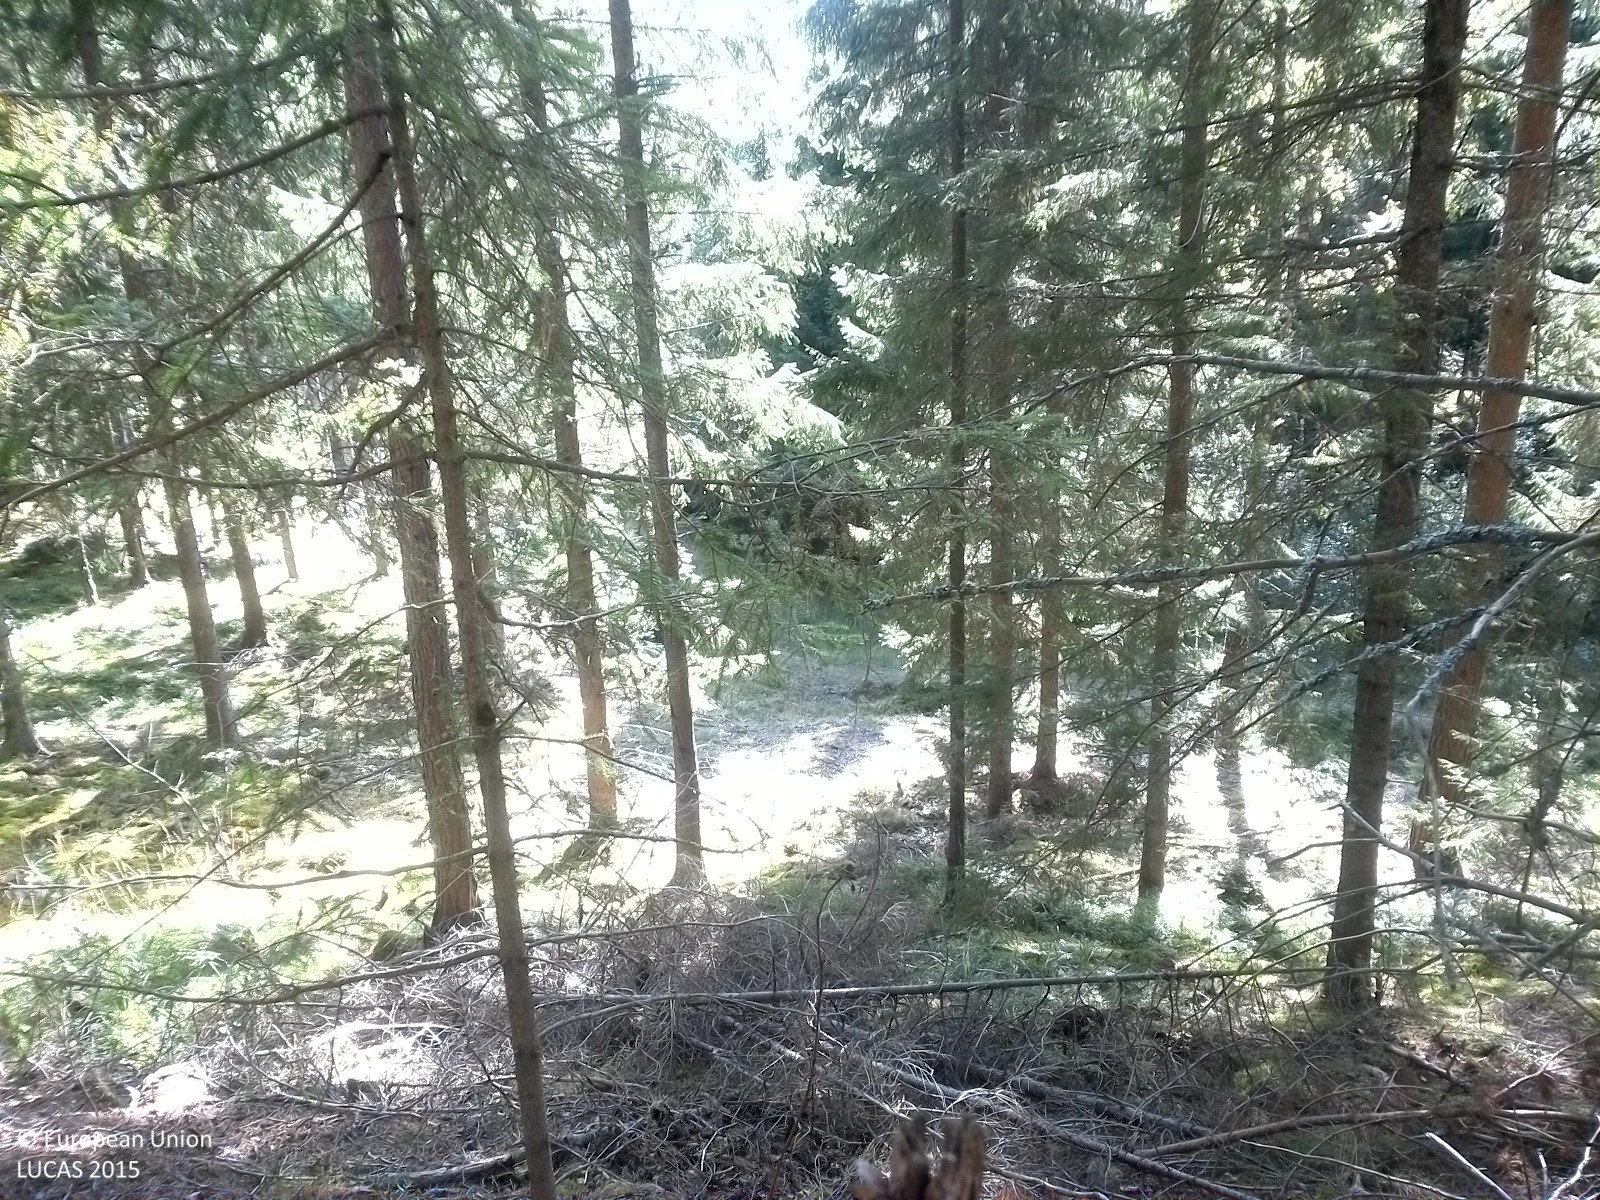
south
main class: Woodland
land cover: Other coniferous woodland
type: boreal forest
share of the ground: 25 - 50 %
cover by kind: coniferous forest trees 40 %, lichens and mosses 30 %, unconsolidated bare surface 20 %, broadleaved forest trees 5 %, herbaceous plants 5 %
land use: Forestry
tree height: > 5 m
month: August
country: SE
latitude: 58.6298
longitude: 15.0397
